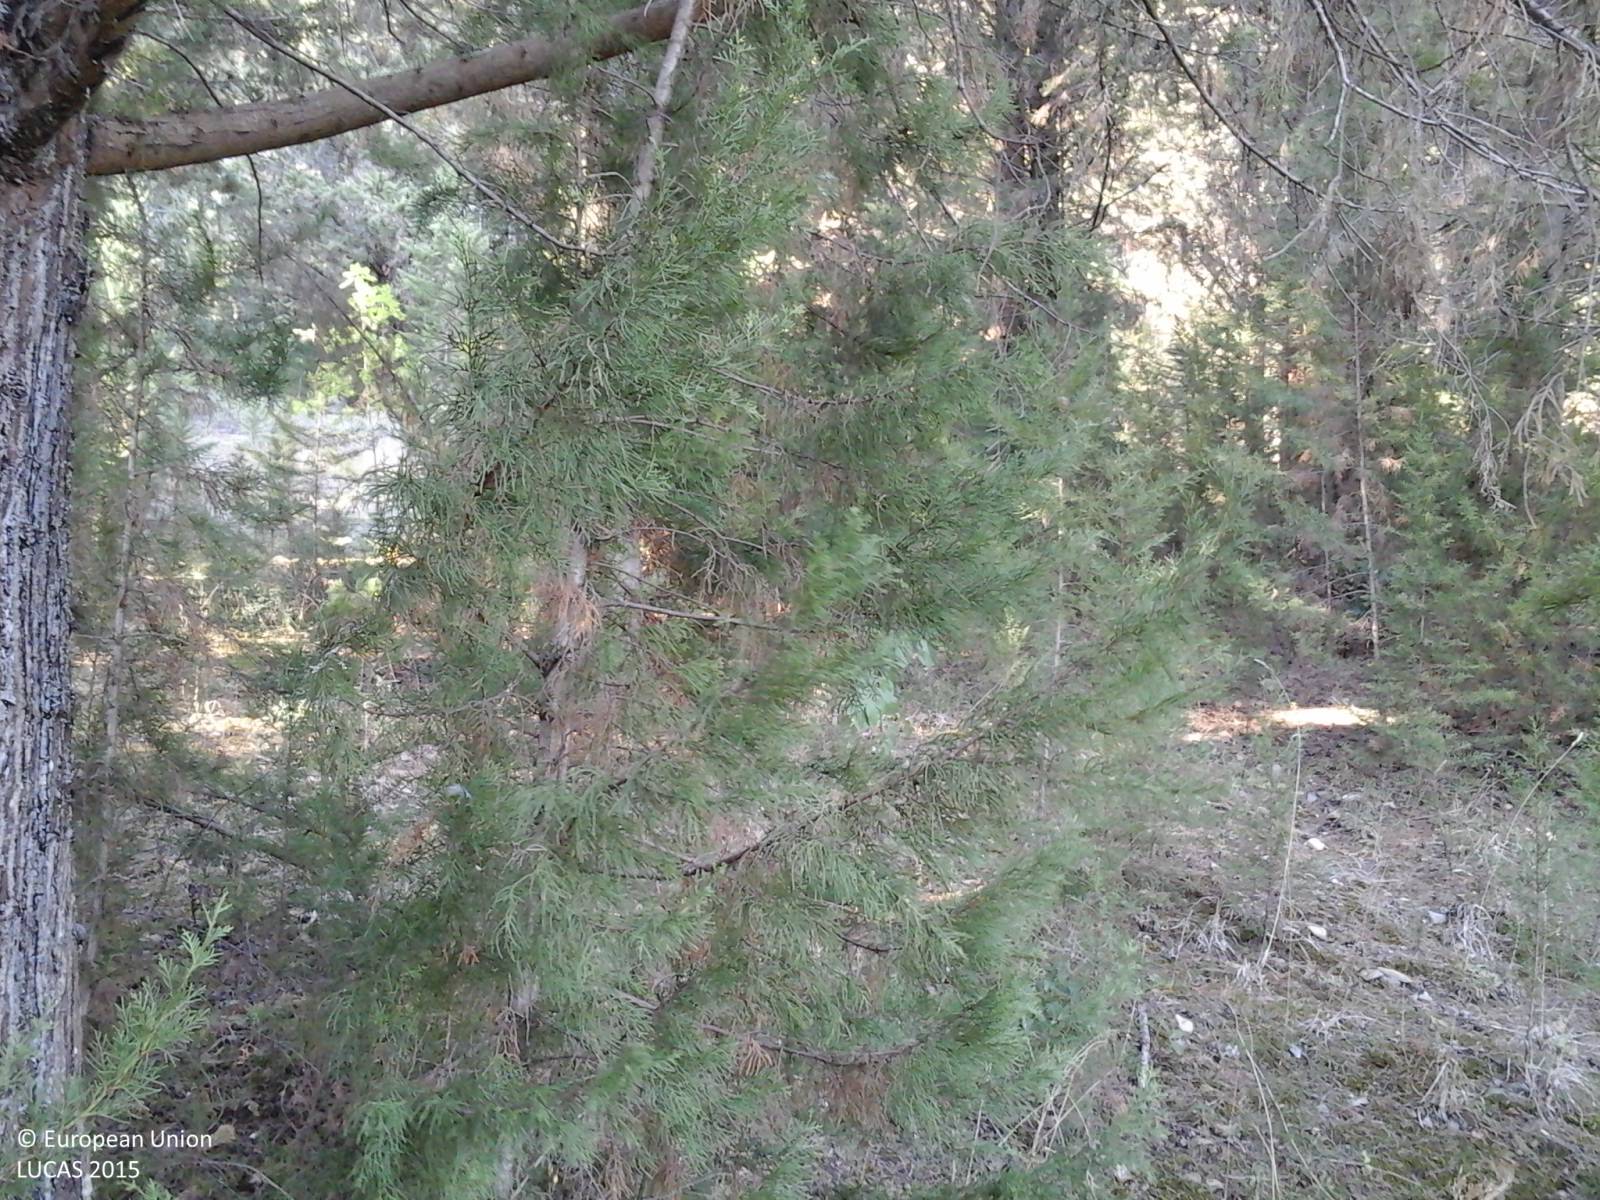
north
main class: Woodland
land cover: Other coniferous woodland
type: coniferous forest of the mediterranean region
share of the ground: > 75 %
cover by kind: coniferous forest trees 90 %, broadleaved forest trees 5 %, herbaceous plants 5 %
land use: Forestry
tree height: > 5 m
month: September
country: IT
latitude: 42.8859
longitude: 12.0629
